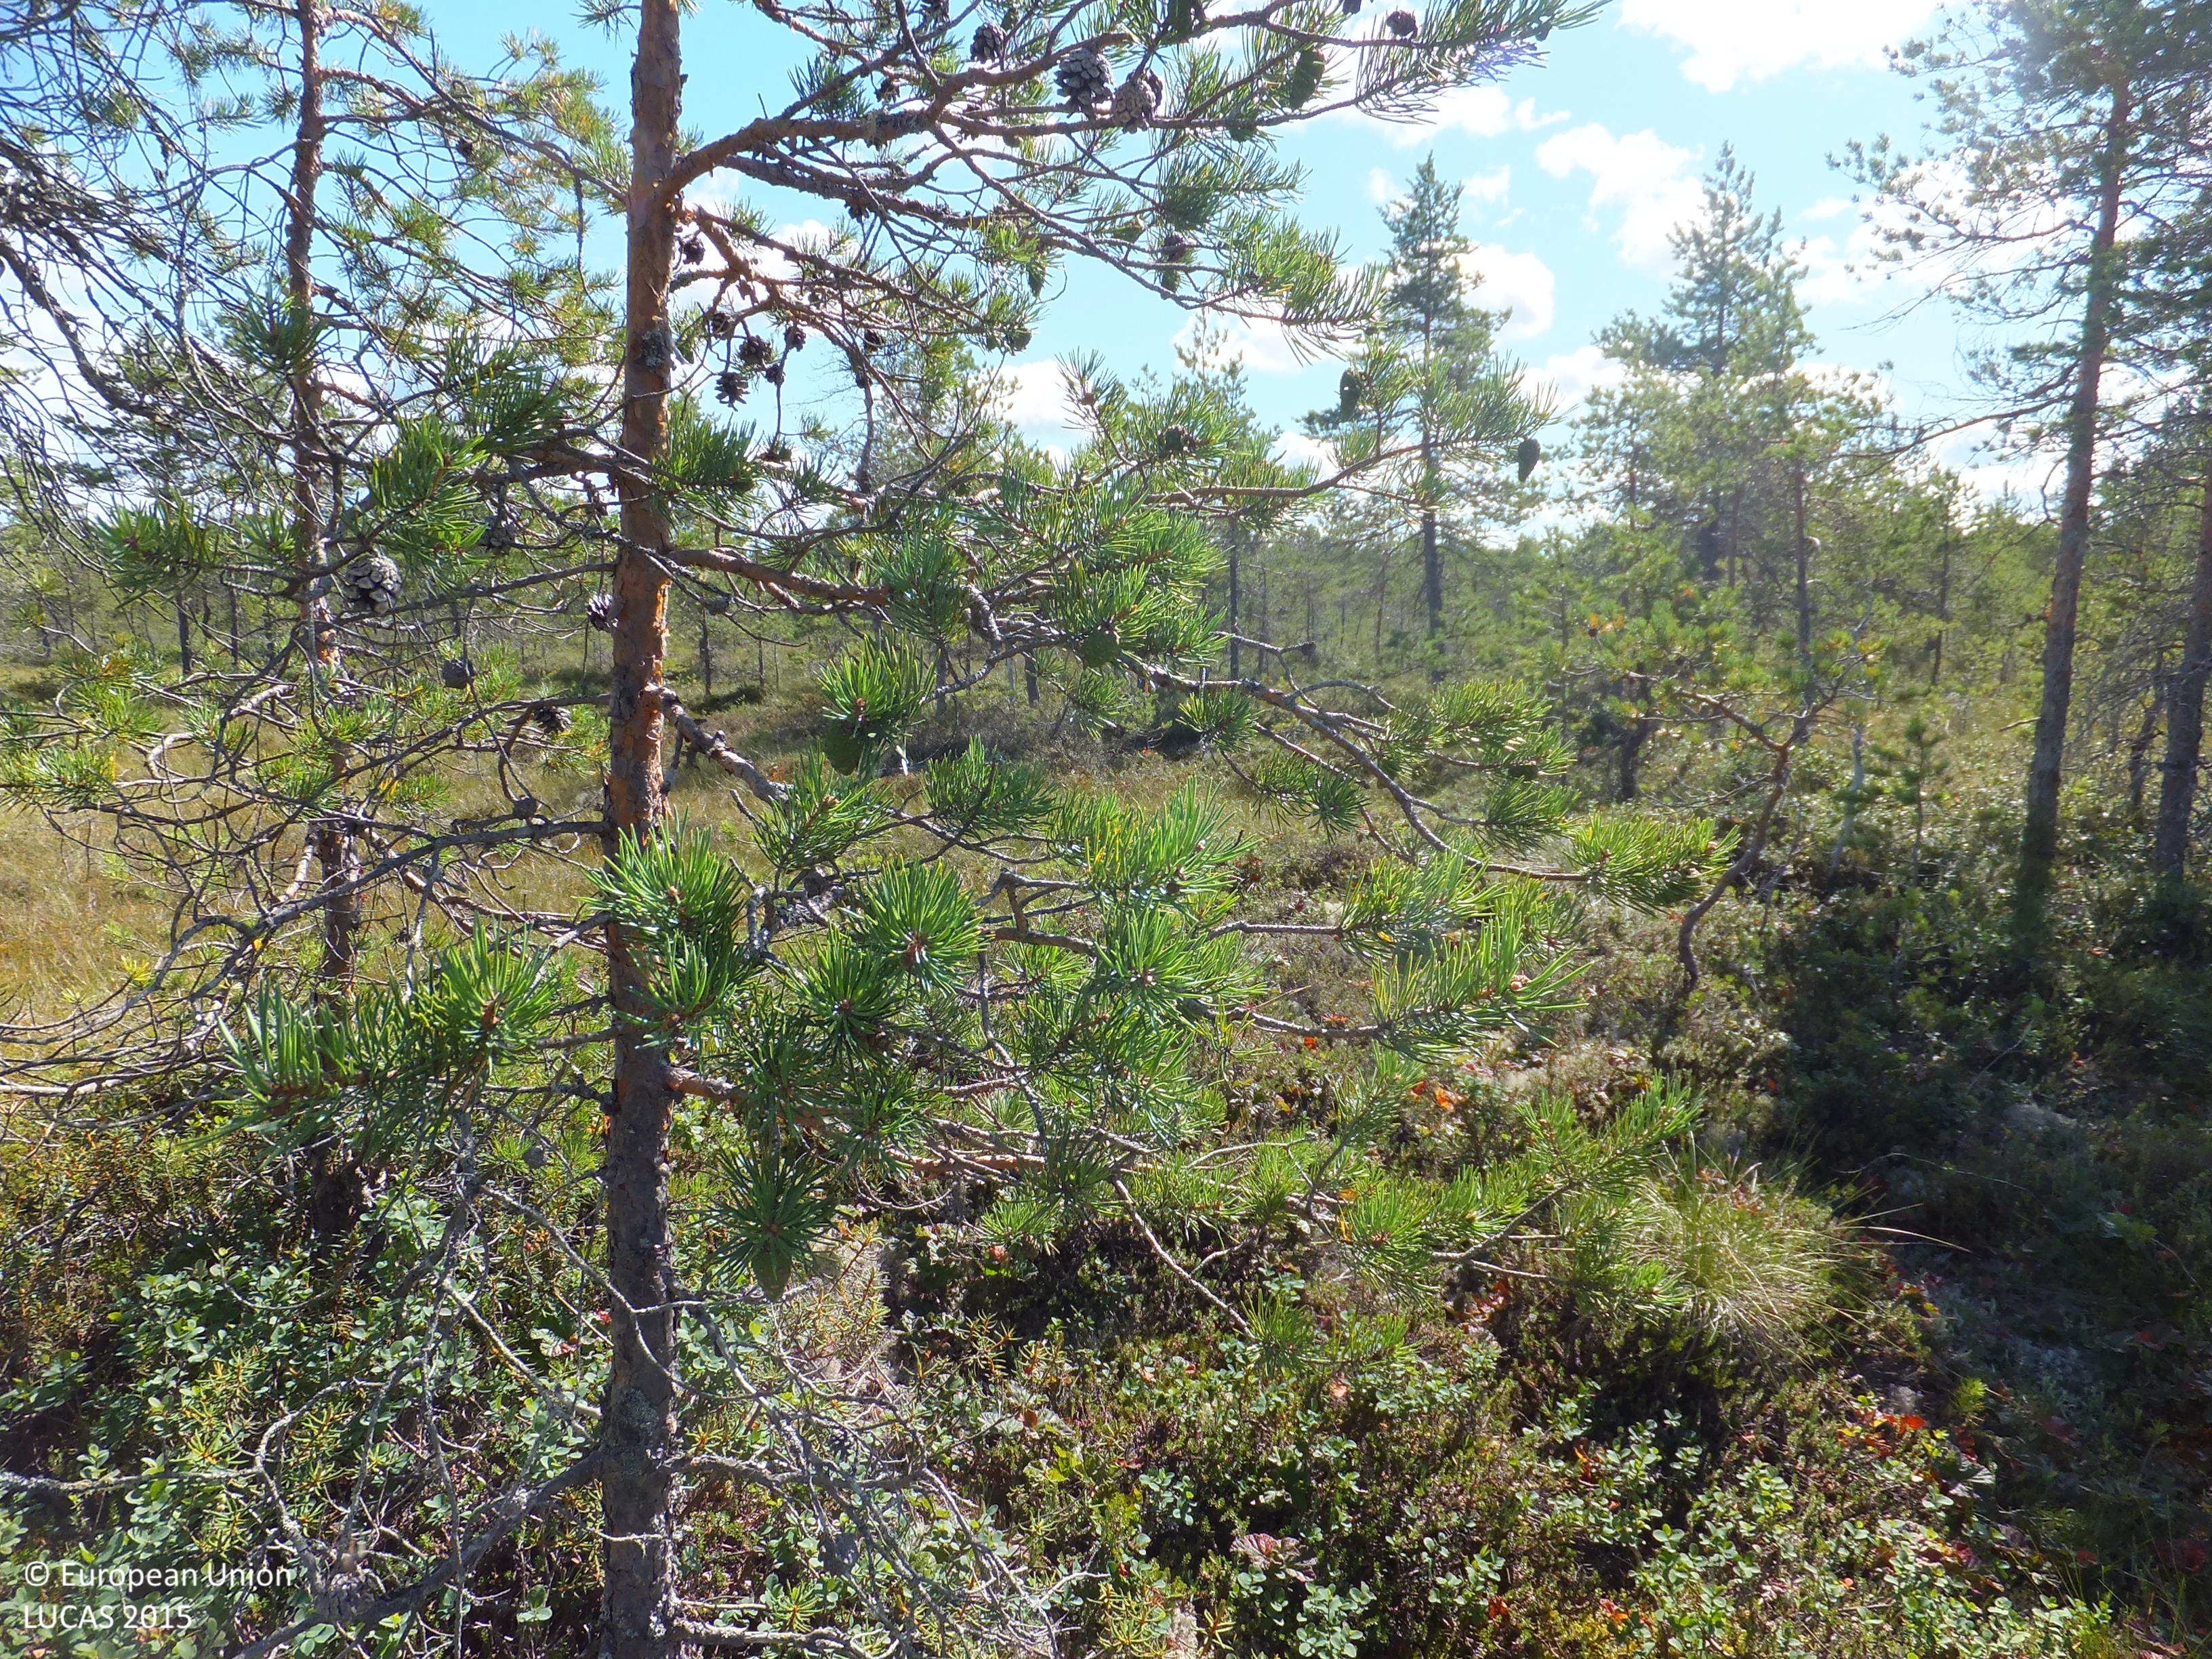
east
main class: Woodland
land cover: Pine dominated coniferous woodland
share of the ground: 10 - 25 %
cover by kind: shrubs 30 %, lichens and mosses 30 %, coniferous forest trees 20 %, herbaceous plants 20 %
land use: Forestry
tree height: < 5 m
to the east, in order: Pine dominated coniferous woodland; Ditches and canals; Pine dominated coniferous woodland; Ditches and canals; Pine dominated coniferous woodland
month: August
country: FI
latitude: 63.0997
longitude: 22.6729
